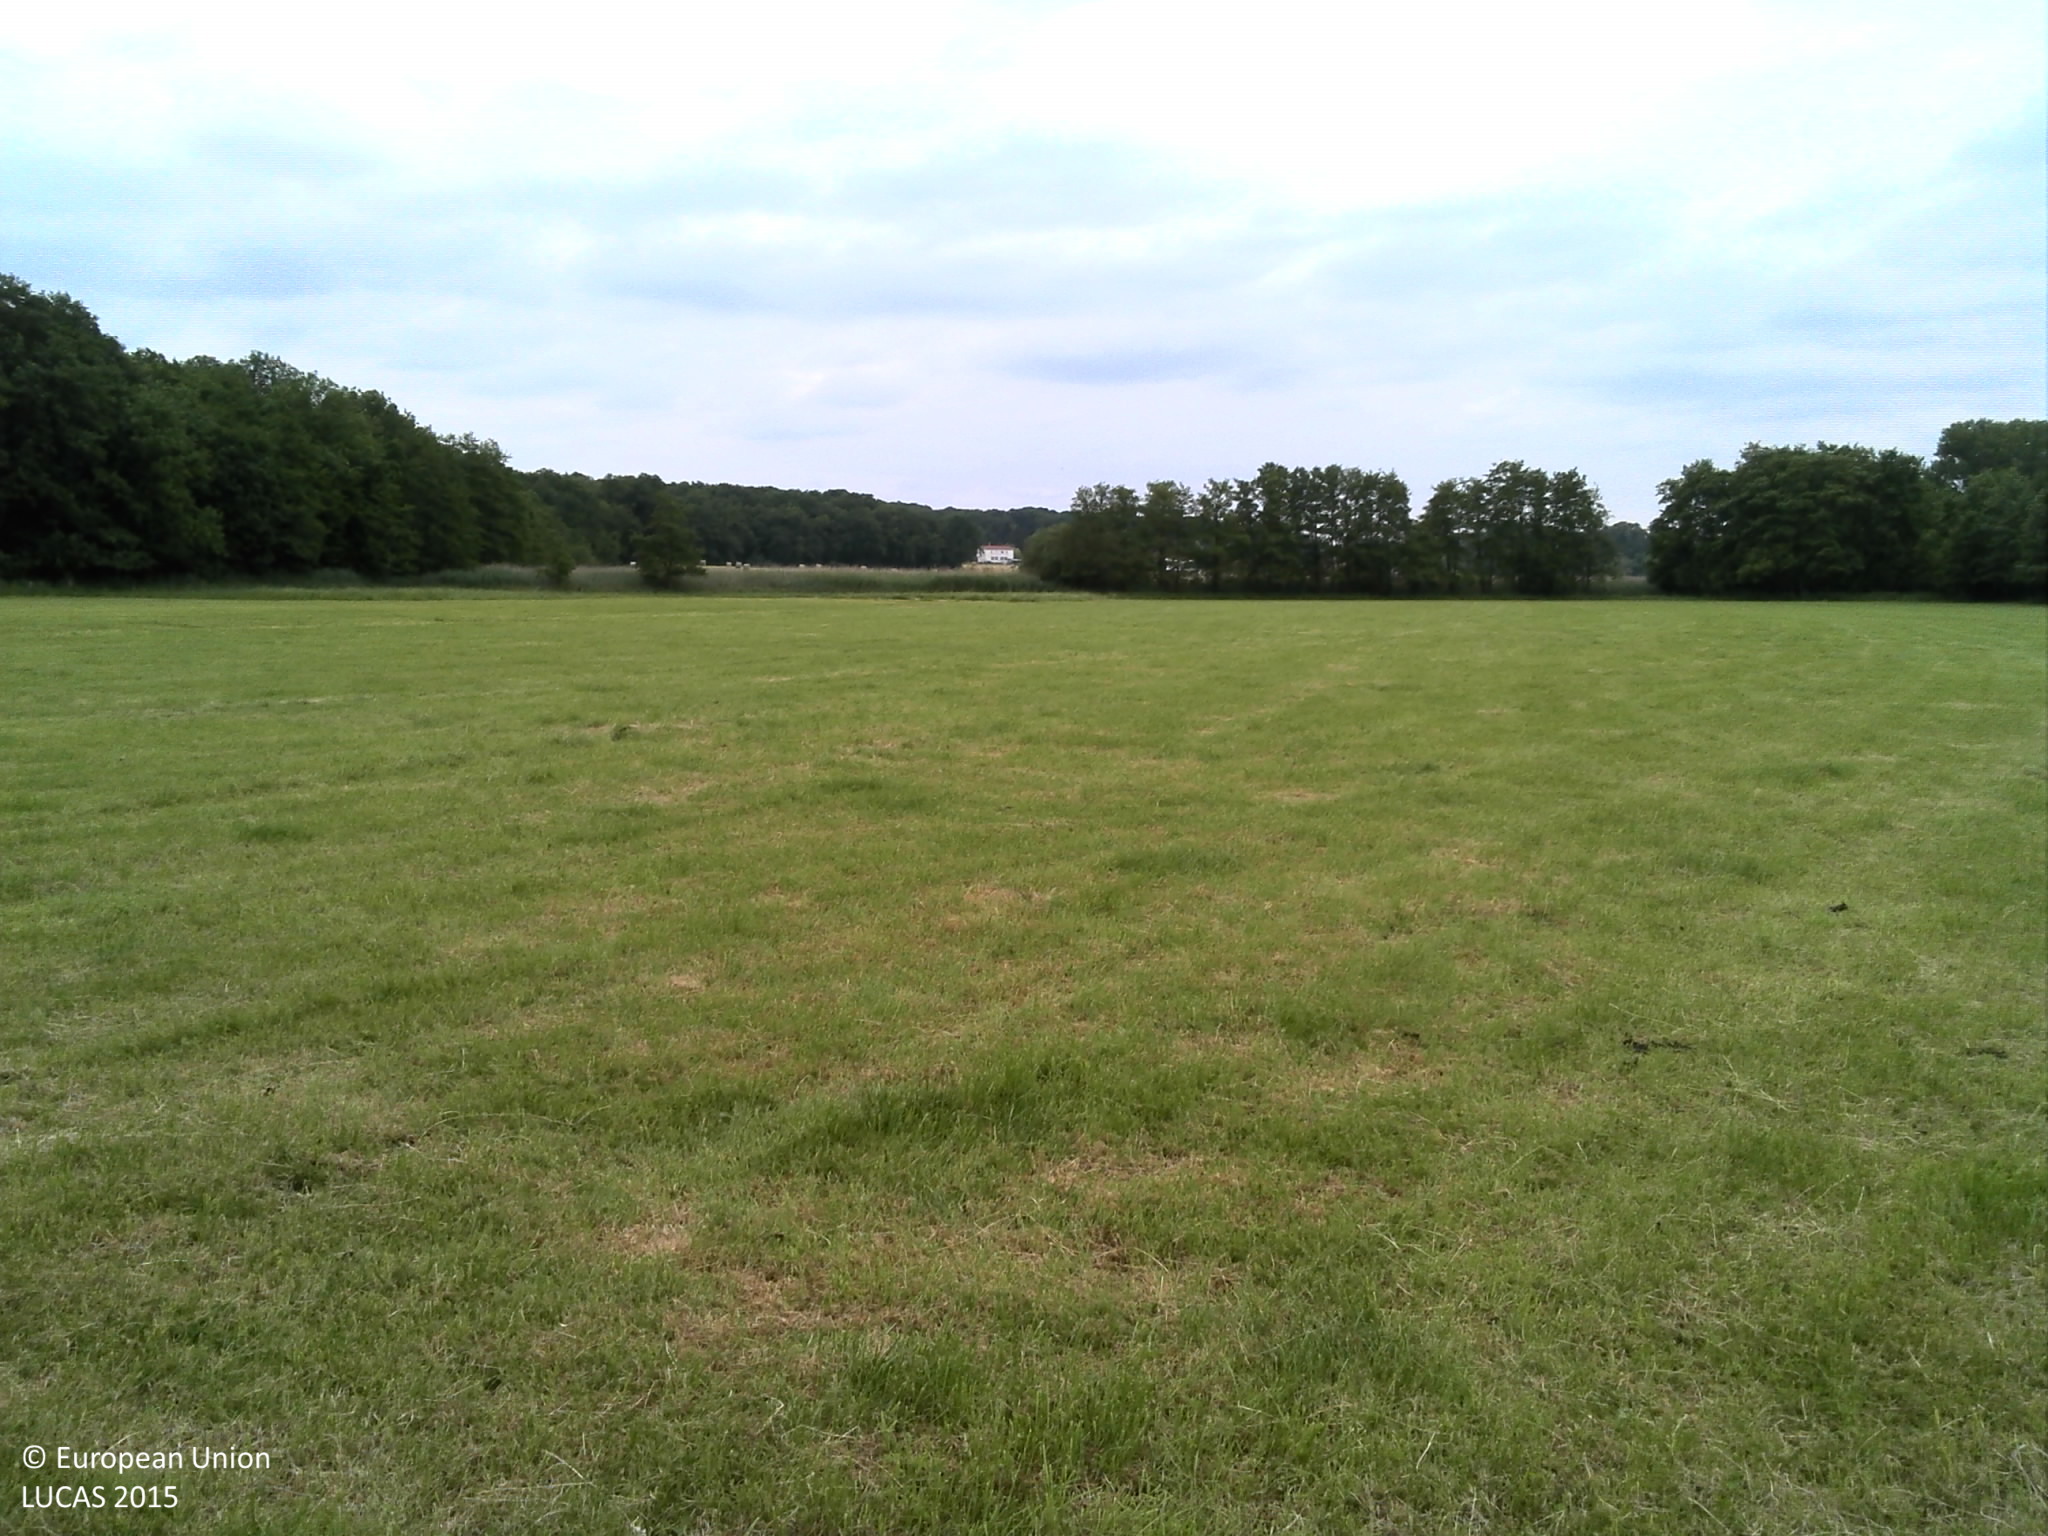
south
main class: Grassland
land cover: Grassland without tree/shrub cover
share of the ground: > 75 %
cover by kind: herbaceous plants 100 %
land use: Agriculture (excluding fallow land and kitchen gardens)
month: June
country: FR
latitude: 48.6996
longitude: 6.8075
